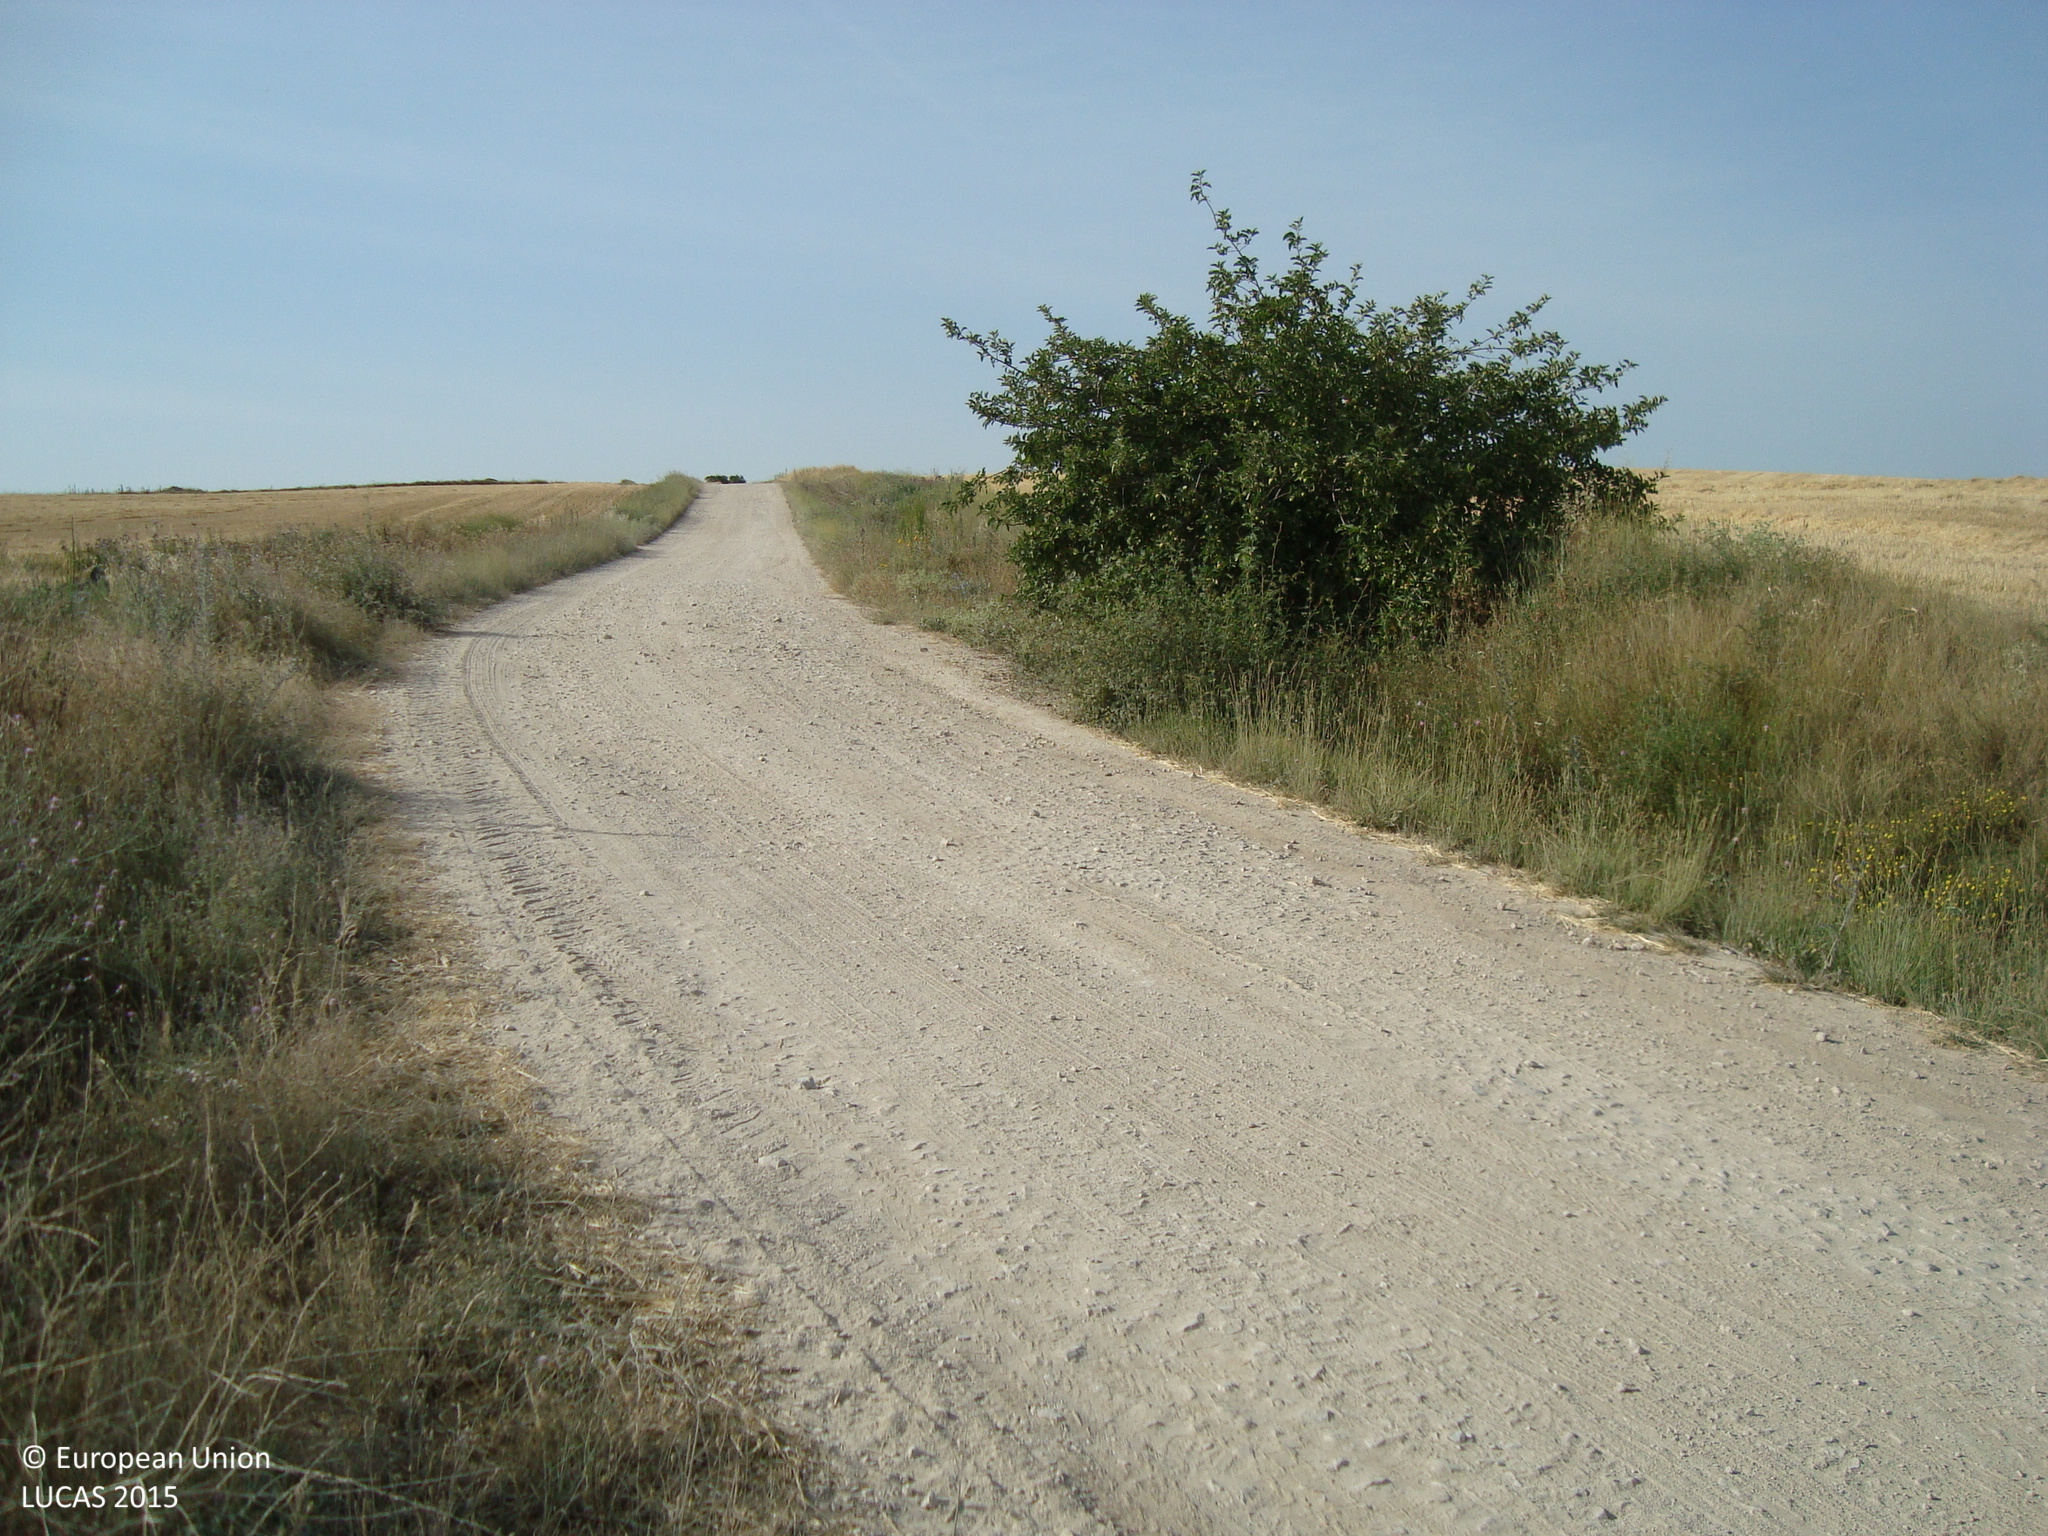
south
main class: Cropland
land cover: Vineyards
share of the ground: 50 - 75 %
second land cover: Other bare soil
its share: > 75 %
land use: Agriculture (excluding fallow land and kitchen gardens)
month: July
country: ES
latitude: 41.7341
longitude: -4.2369
